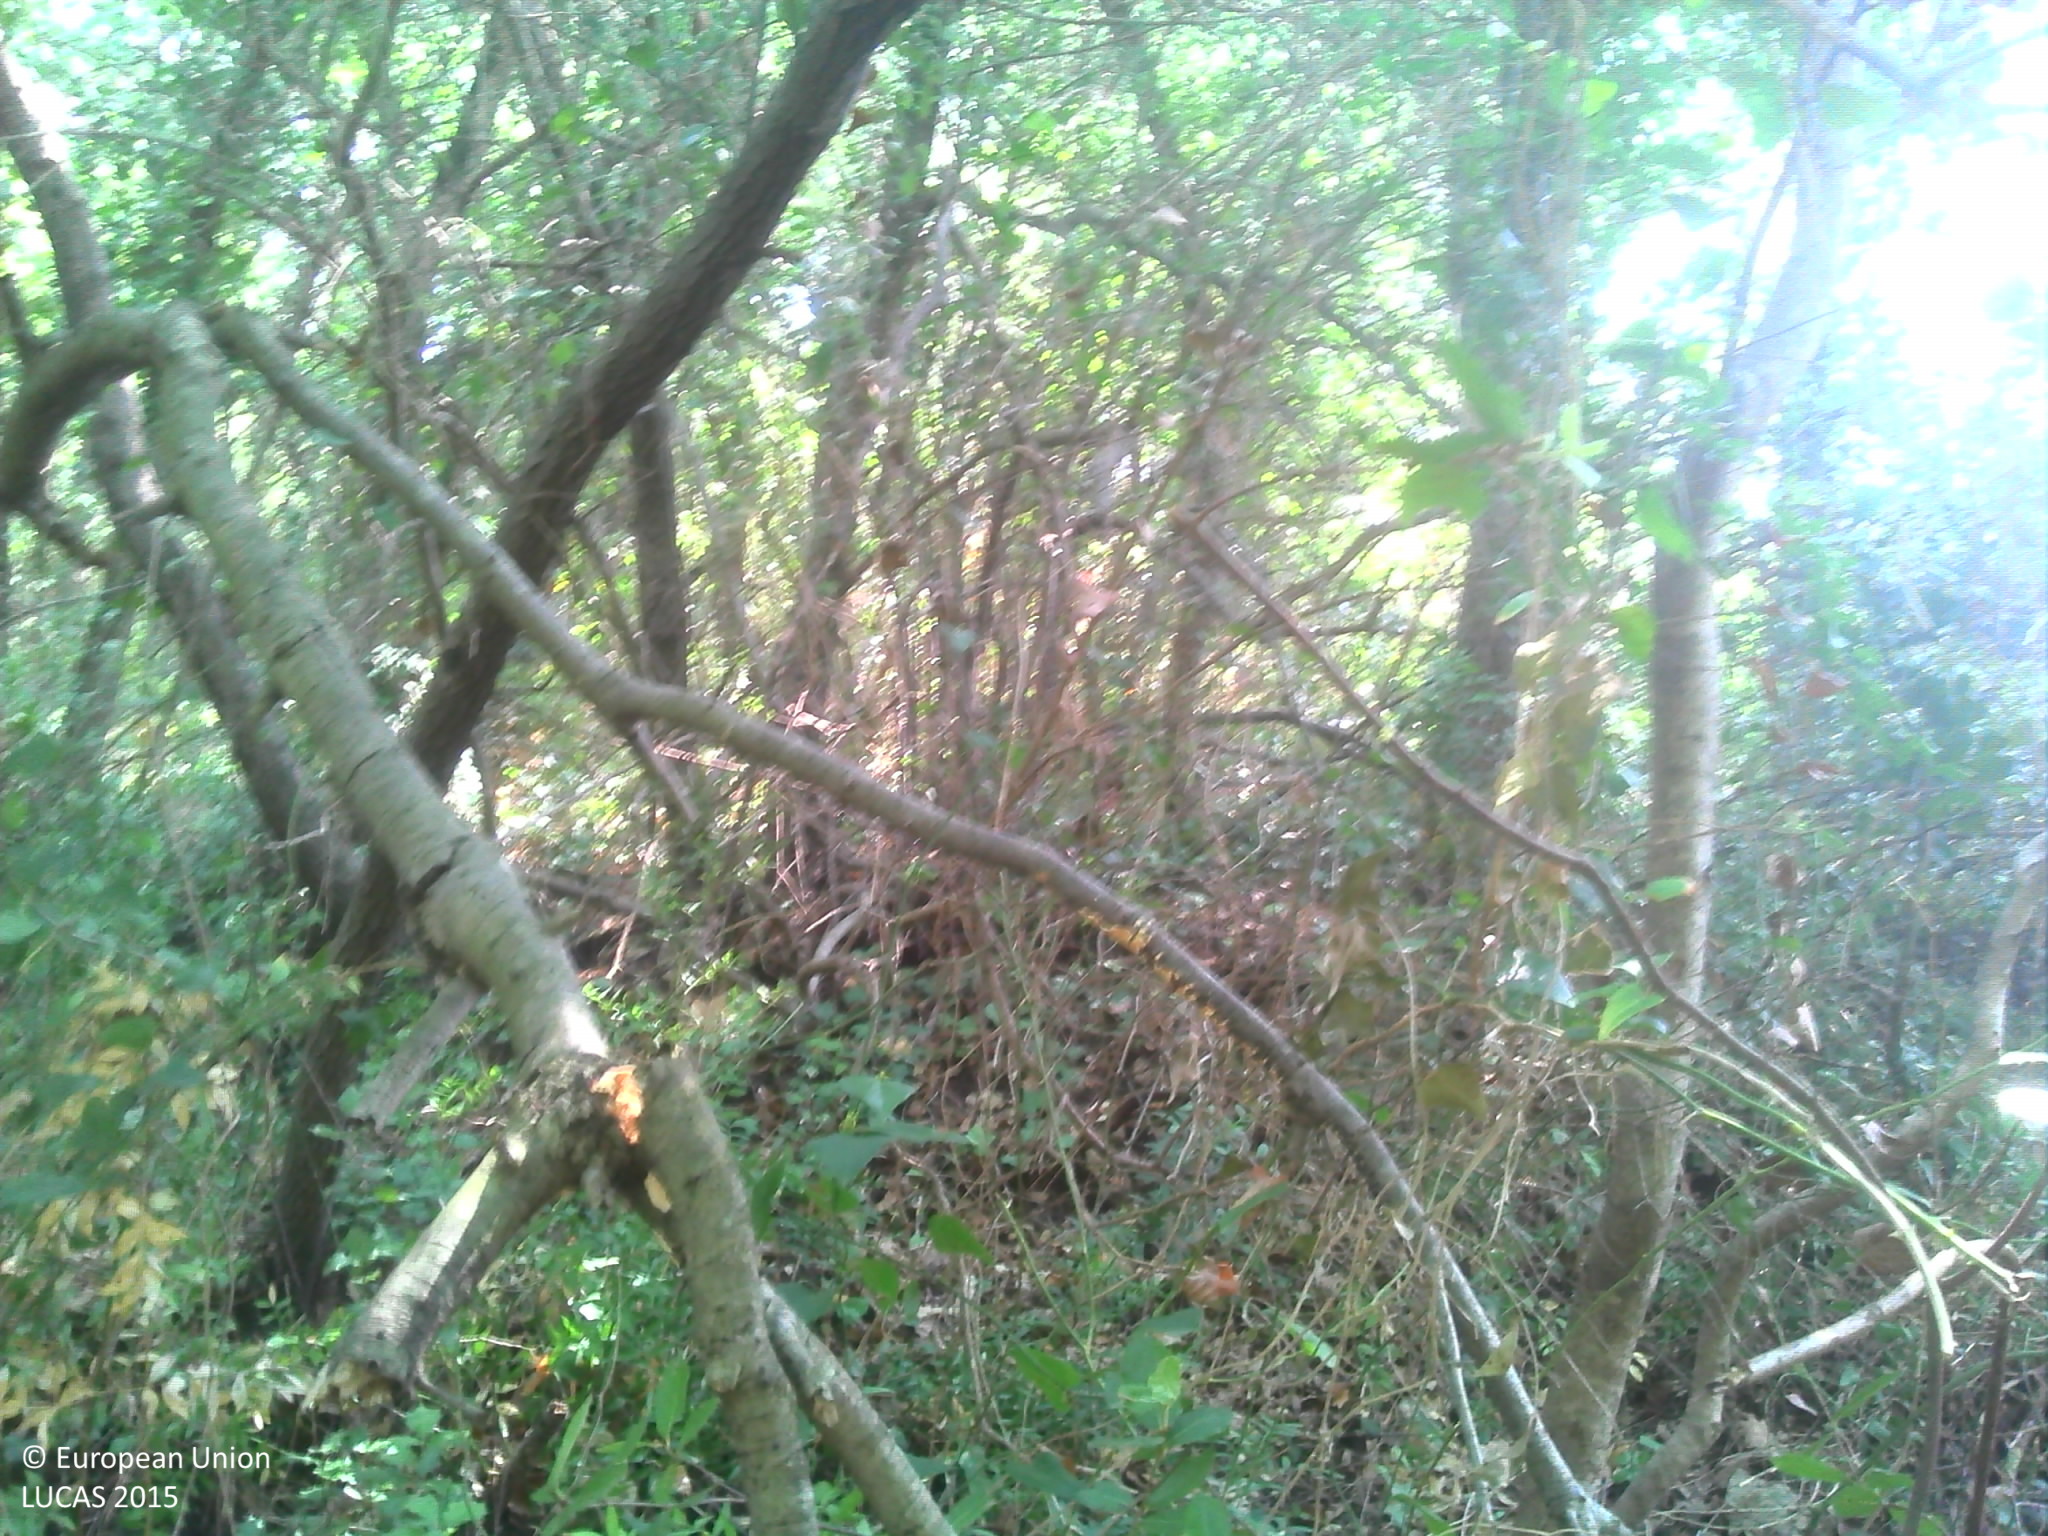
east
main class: Woodland
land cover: Pine dominated mixed woodland
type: broadleaved evergreen forest
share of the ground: > 75 %
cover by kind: coniferous forest trees 50 %, broadleaved forest trees 30 %, unconsolidated bare surface 10 %
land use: Semi-natural and natural areas not in use
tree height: > 5 m
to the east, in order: Pine dominated mixed woodland
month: July
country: FR
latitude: 43.3994
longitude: 6.2926
